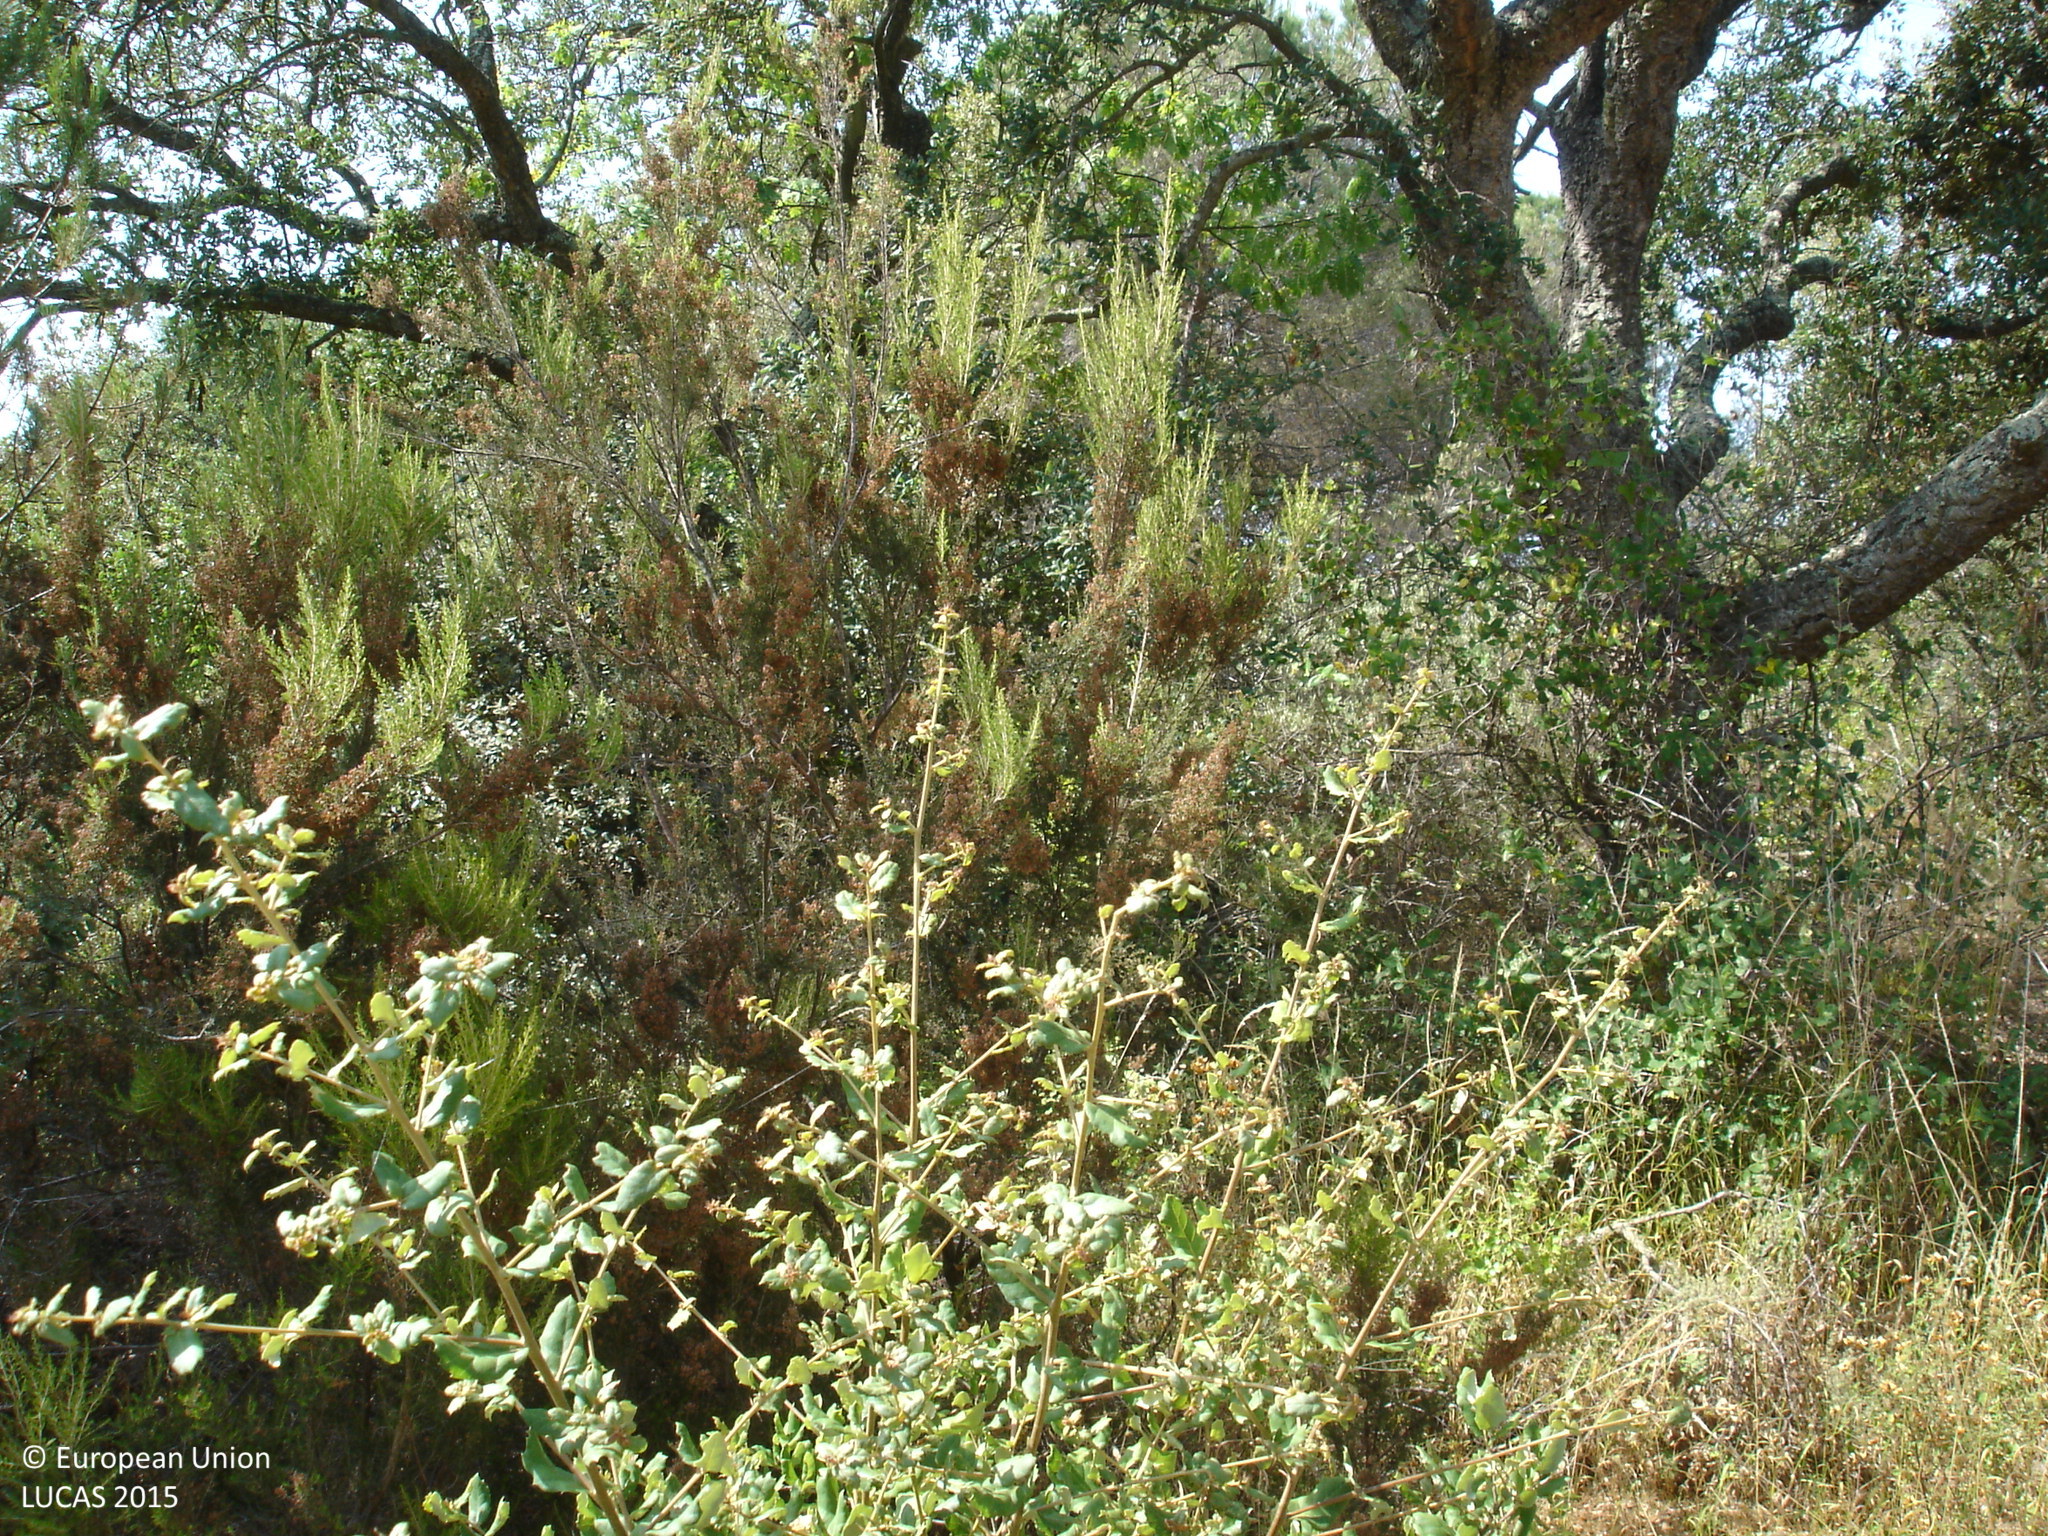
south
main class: Woodland
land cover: Other mixed woodland
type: thermophilous deciduous forest
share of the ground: 25 - 50 %
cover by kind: herbaceous plants 55 %, broadleaved forest trees 30 %, coniferous forest trees 15 %
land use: Forestry
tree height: > 5 m
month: July
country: ES
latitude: 41.8167
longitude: 3.0465
